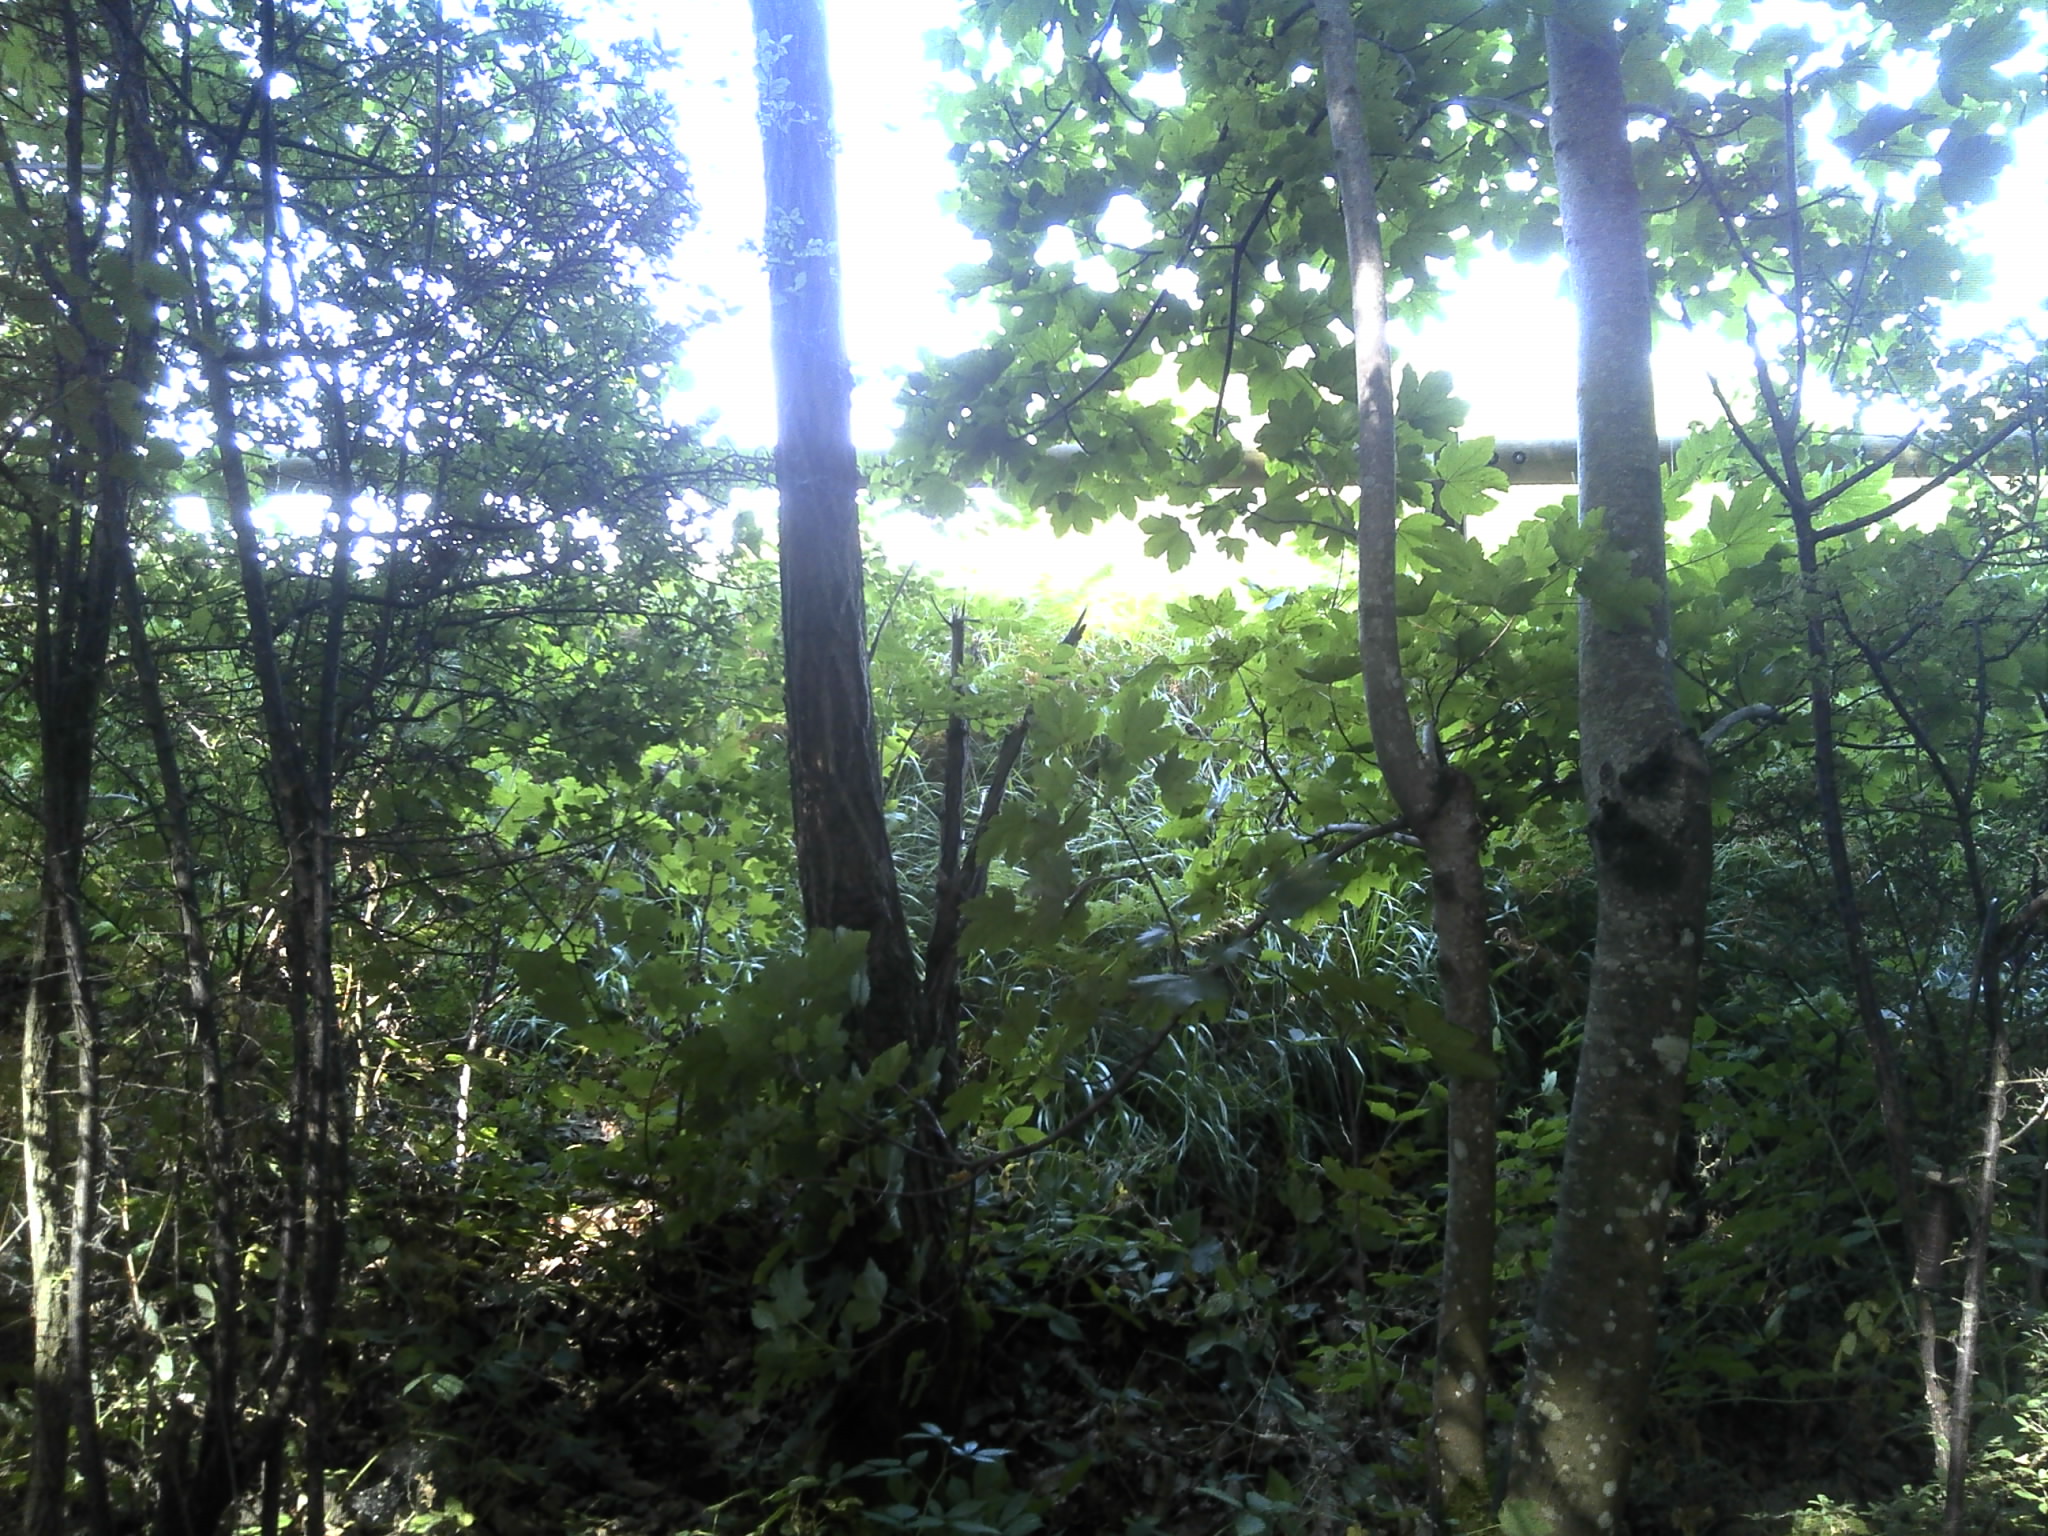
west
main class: Woodland
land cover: Broadleaved woodland
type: mesophytic deciduous forest
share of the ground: > 75 %
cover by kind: broadleaved forest trees 90 %, shrubs 5 %, herbaceous plants 5 %
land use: Forestry
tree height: > 5 m
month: July
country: FR
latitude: 47.0166
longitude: 1.6086
